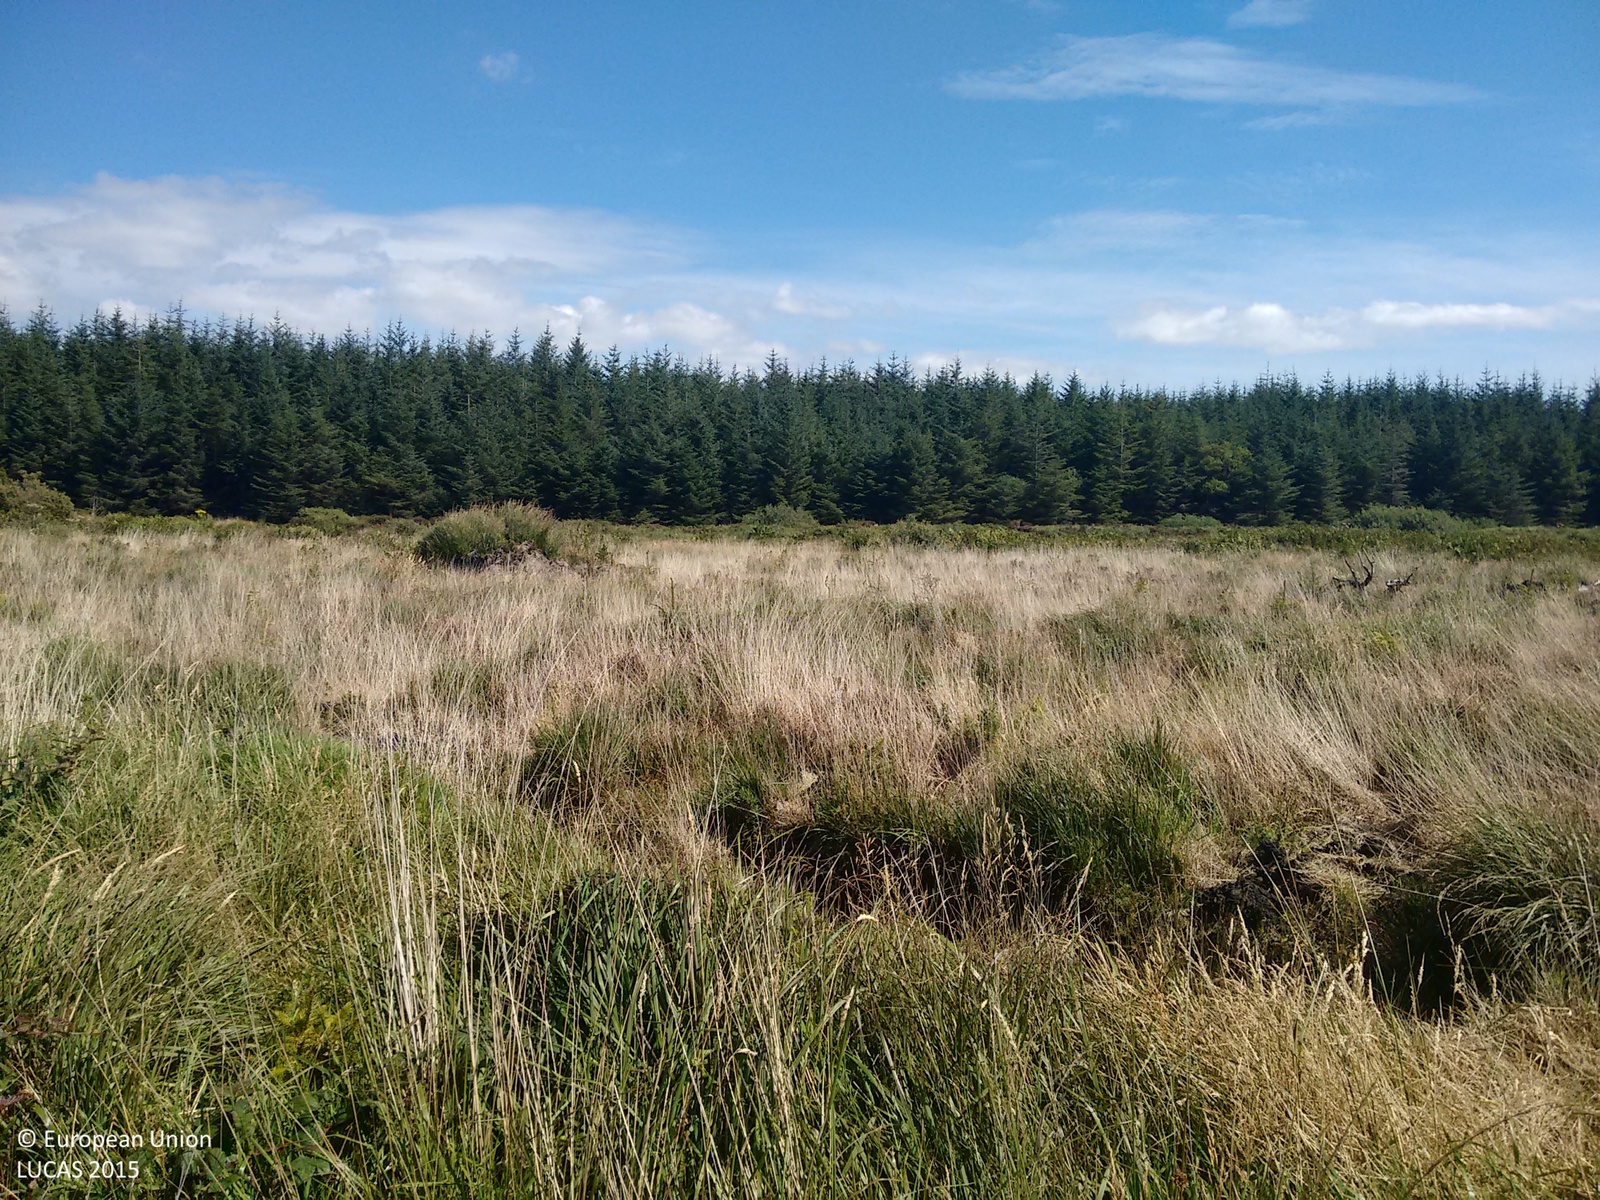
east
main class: Woodland
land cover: Spruce dominated coniferous woodland
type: exotic forest
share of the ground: > 75 %
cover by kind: coniferous forest trees 50 %, herbaceous plants 50 %
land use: Forestry
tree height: < 5 m
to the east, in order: Spruce dominated coniferous woodland; Ditches and canals; Spruce dominated coniferous woodland; Ditches and canals; Spruce dominated coniferous woodland; Tracks; Spruce dominated coniferous woodland
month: August
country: IE
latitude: 51.5664
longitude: -9.5219
